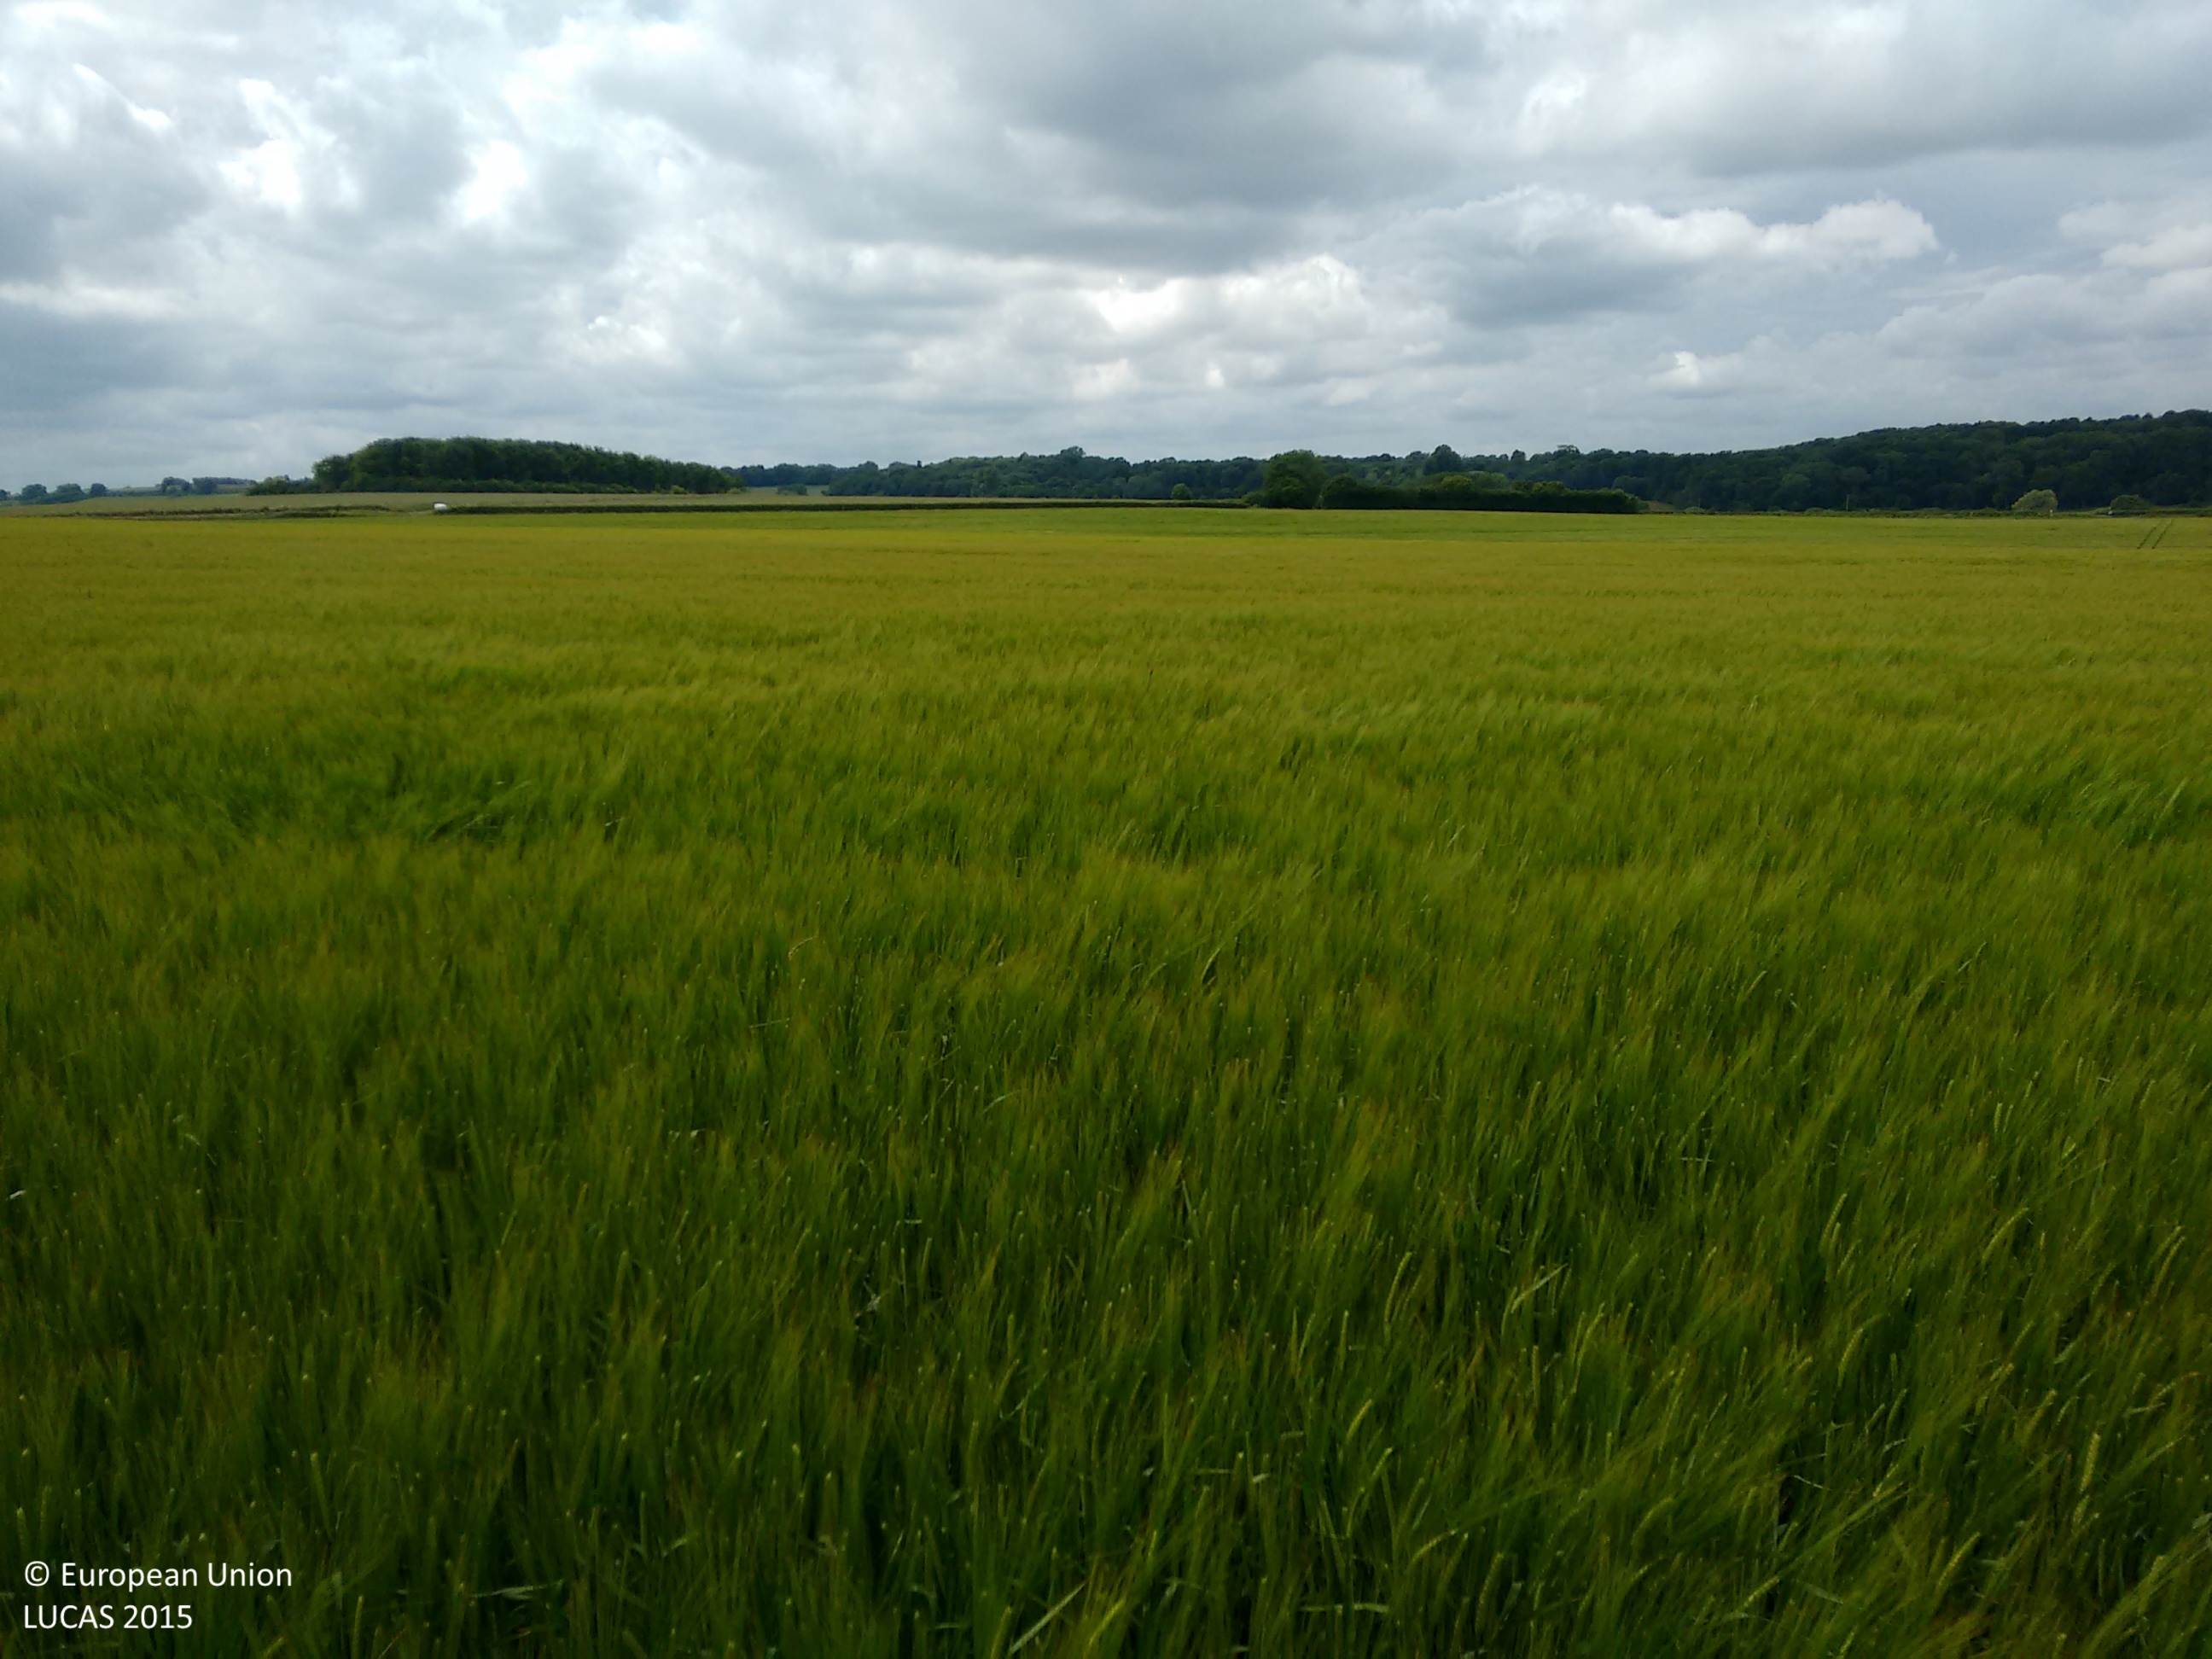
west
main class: Cropland
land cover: Barley
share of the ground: > 75 %
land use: Agriculture (excluding fallow land and kitchen gardens)
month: June
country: GB
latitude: 51.3774
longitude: -1.5307
